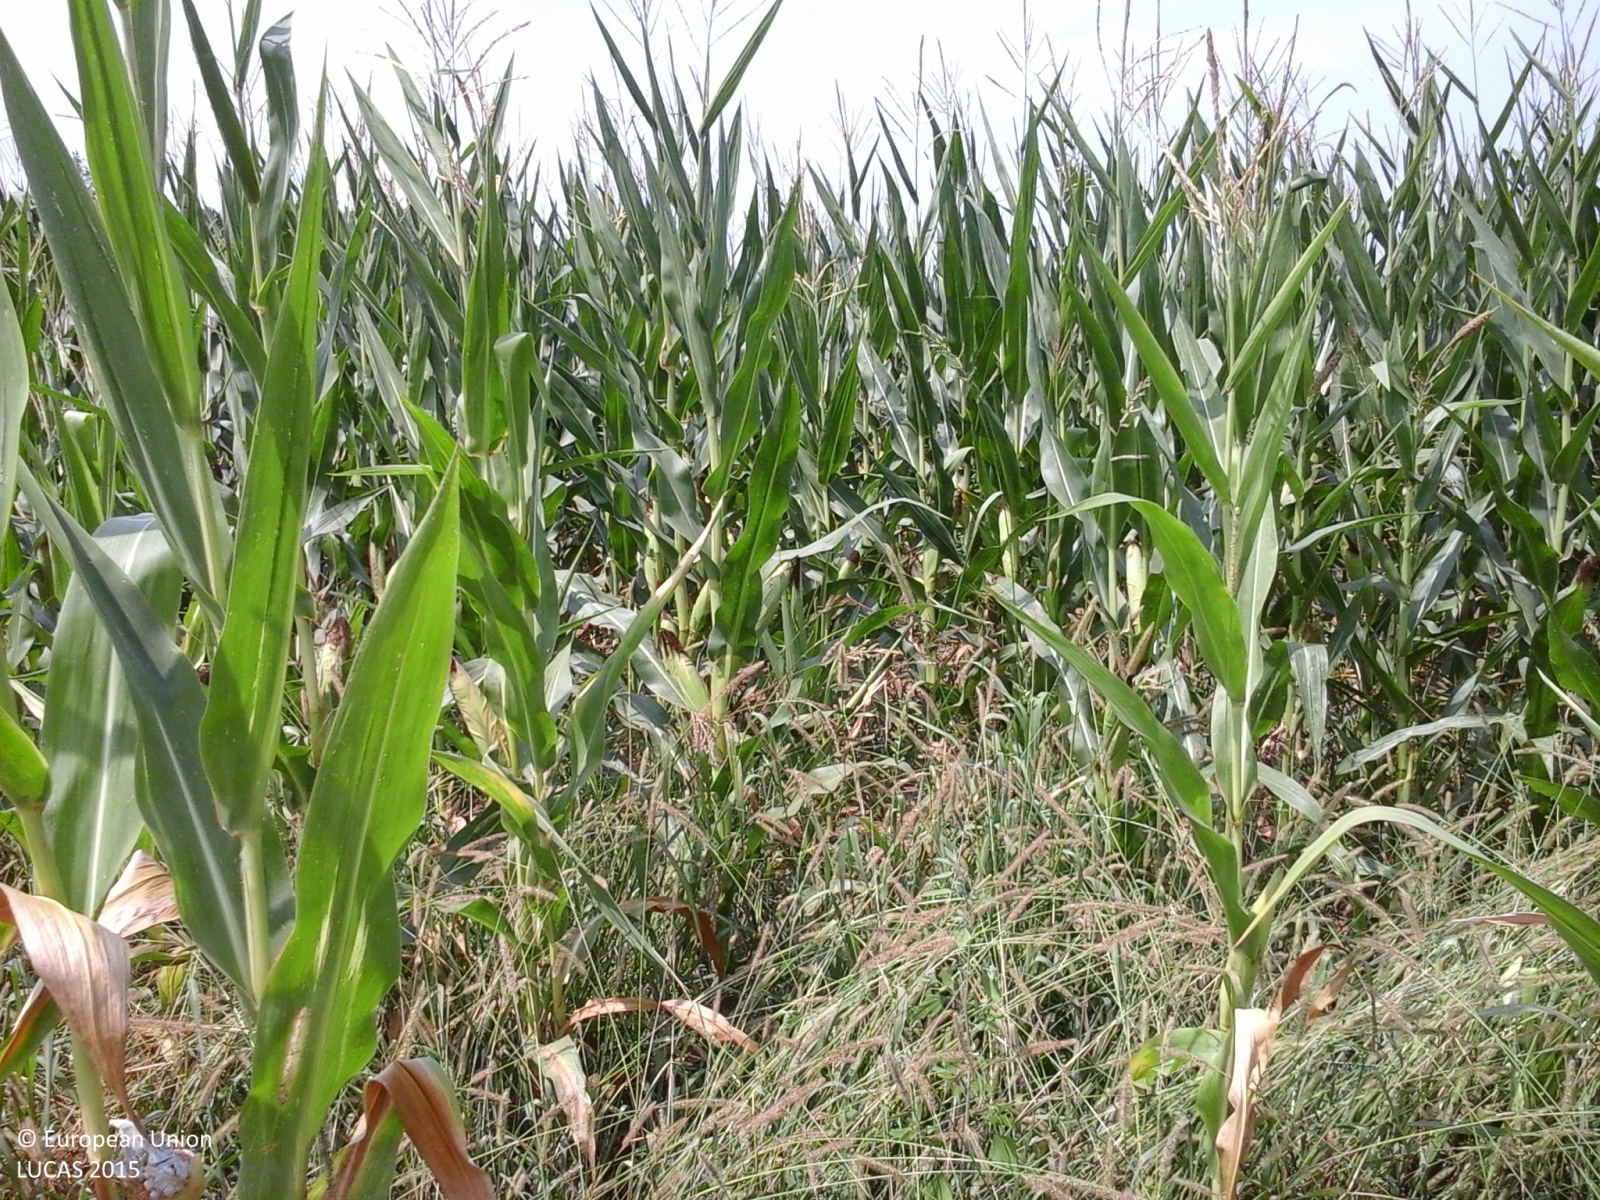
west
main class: Cropland
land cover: Maize
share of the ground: > 75 %
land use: Agriculture (excluding fallow land and kitchen gardens)
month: July
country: IT
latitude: 44.7966
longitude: 7.8173
